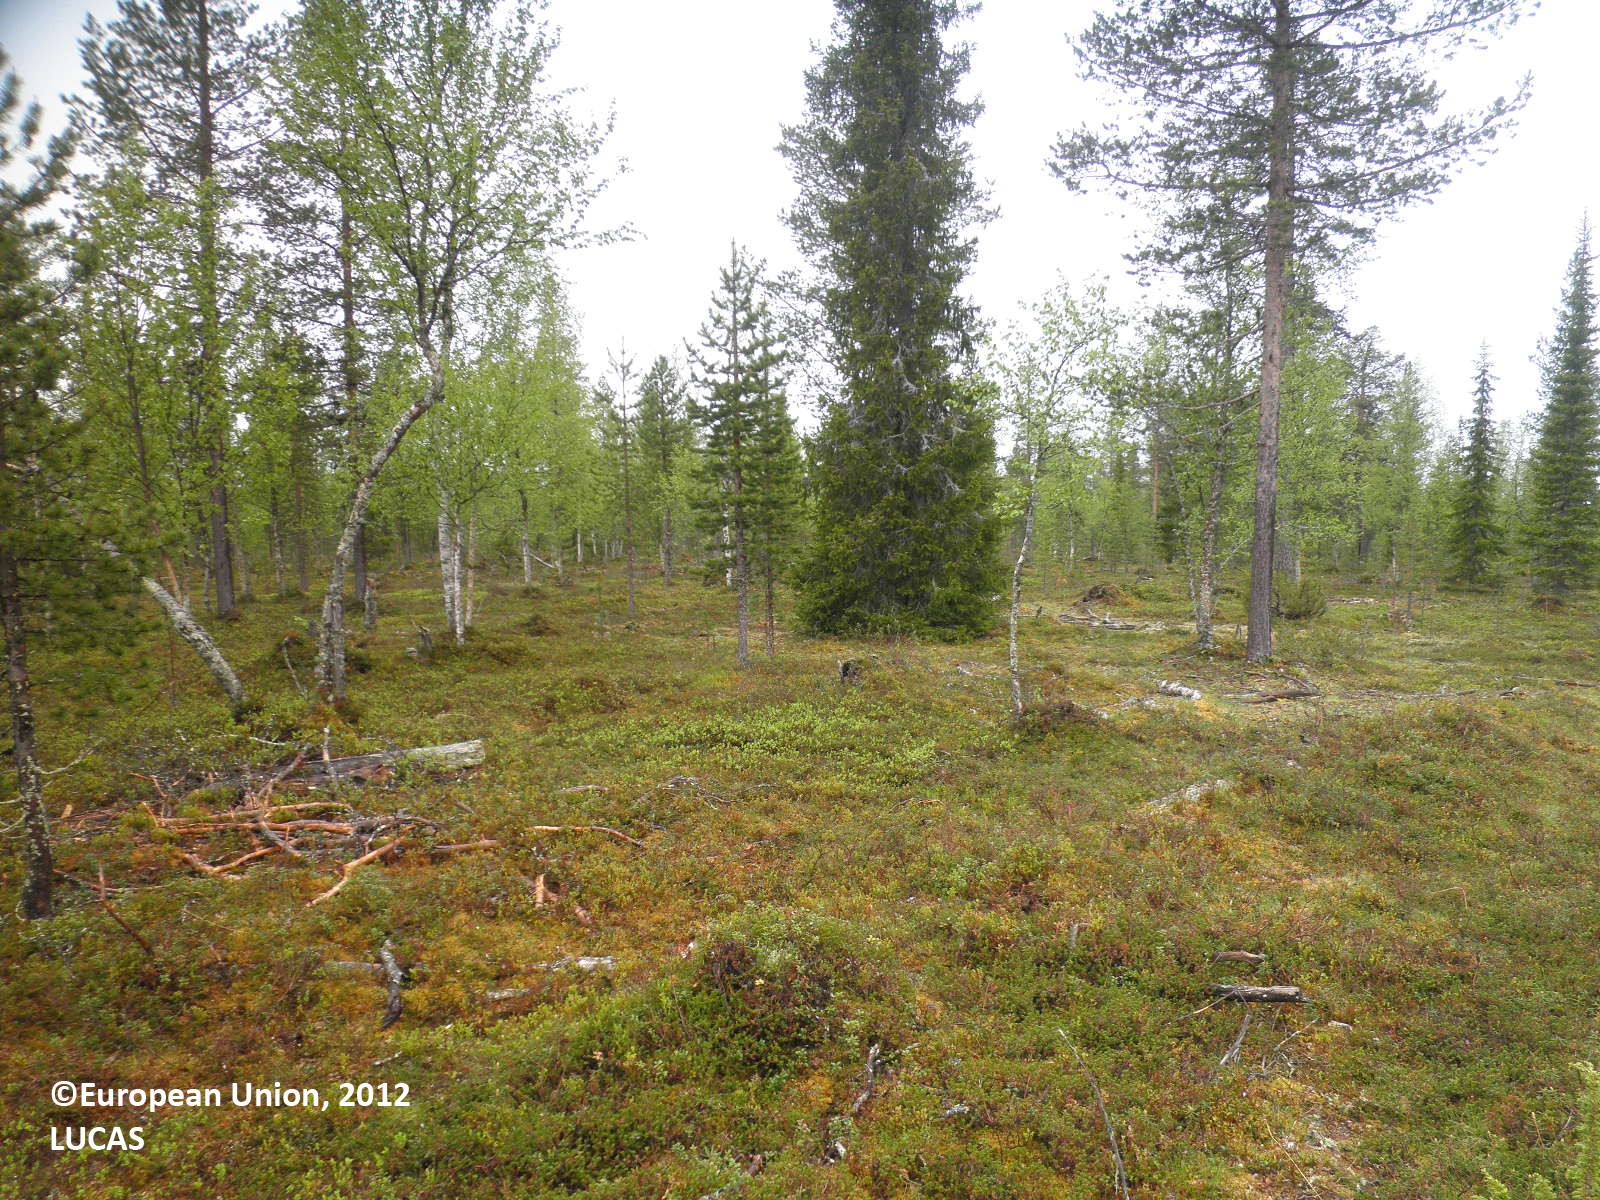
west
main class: Woodland
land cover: Pine dominated mixed woodland
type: boreal forest
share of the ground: 10 - 25 %
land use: Forestry
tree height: > 5 m
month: June
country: FI
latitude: 68.1110
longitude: 25.5435
